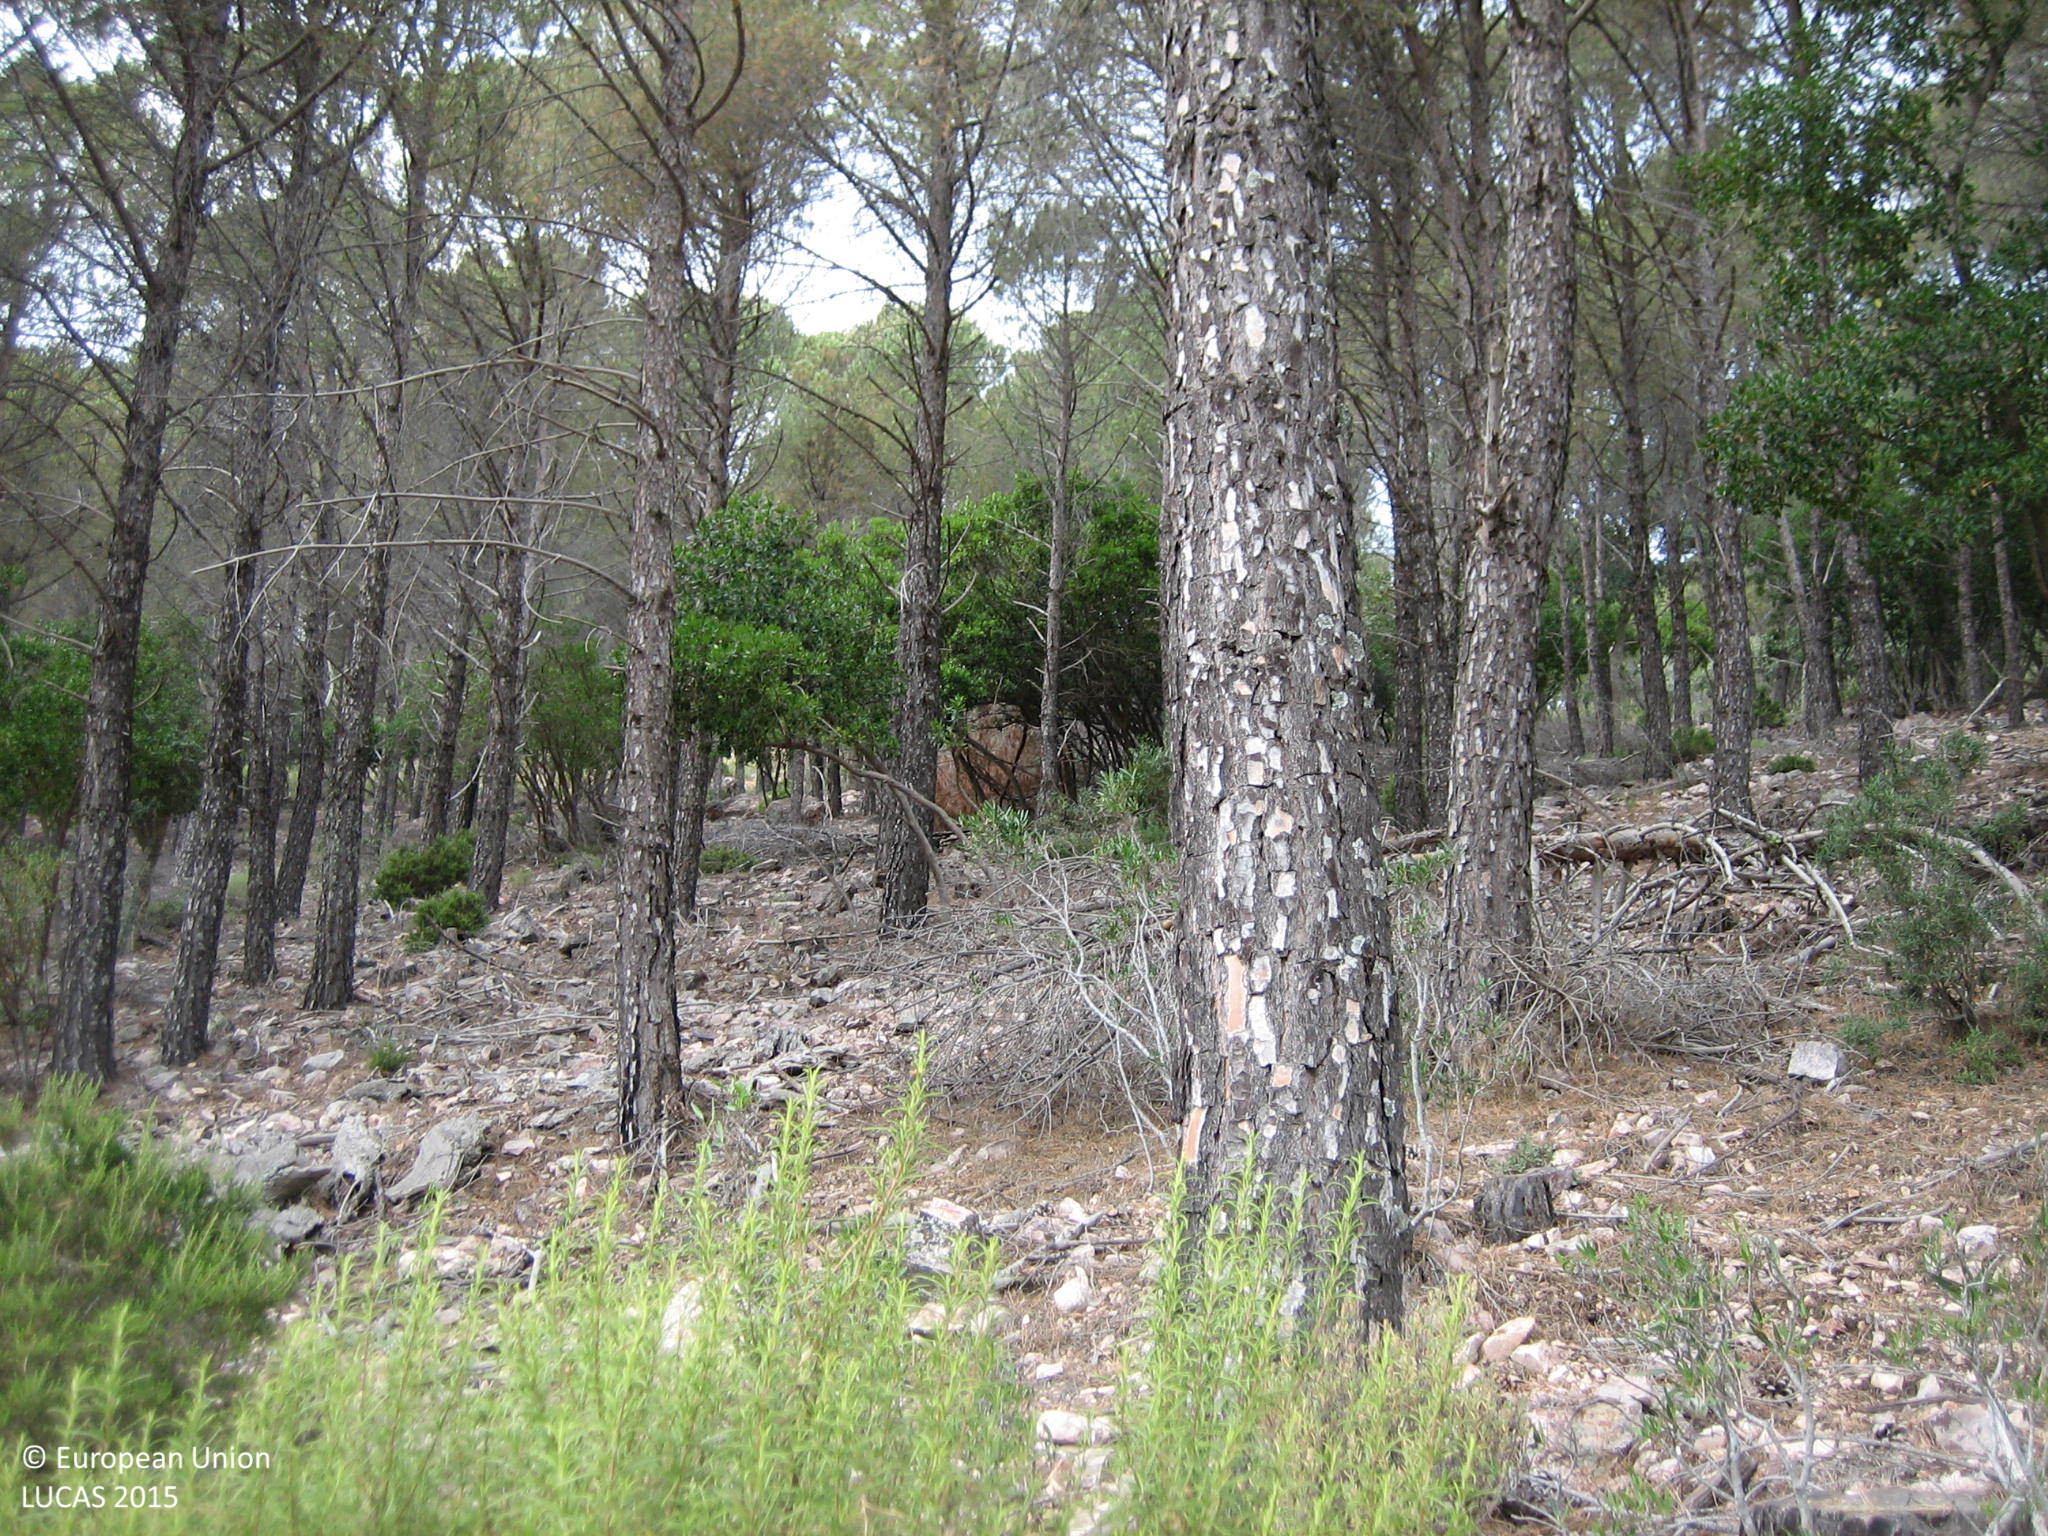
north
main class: Woodland
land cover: Pine dominated coniferous woodland
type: coniferous forest of the mediterranean region
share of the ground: > 75 %
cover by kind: coniferous forest trees 90 %, consolidated bare surface 10 %
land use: Forestry
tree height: > 5 m
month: June
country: ES
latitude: 39.2715
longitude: -4.8864
